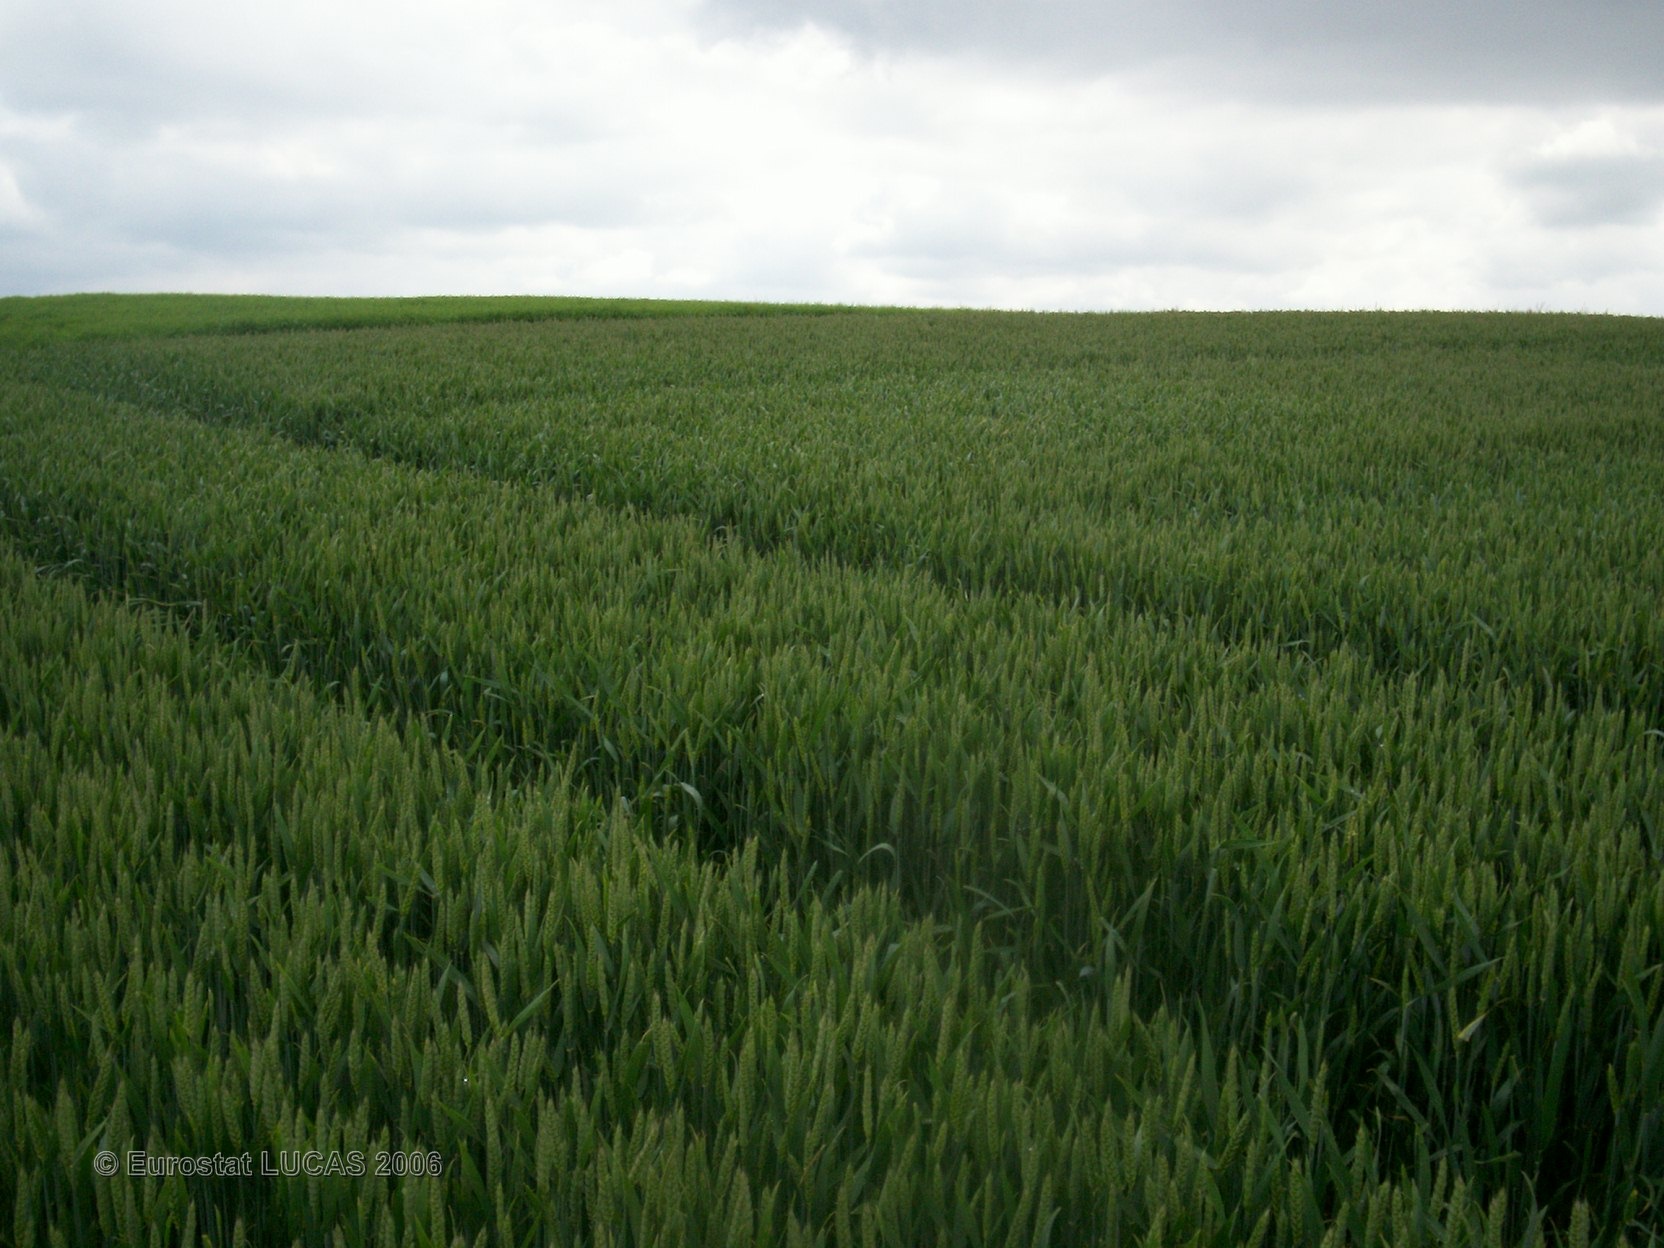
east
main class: Cropland
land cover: Common wheat
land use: Agriculture (excluding fallow land and kitchen gardens)
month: June
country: FR
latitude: 48.5889
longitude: 4.4520
